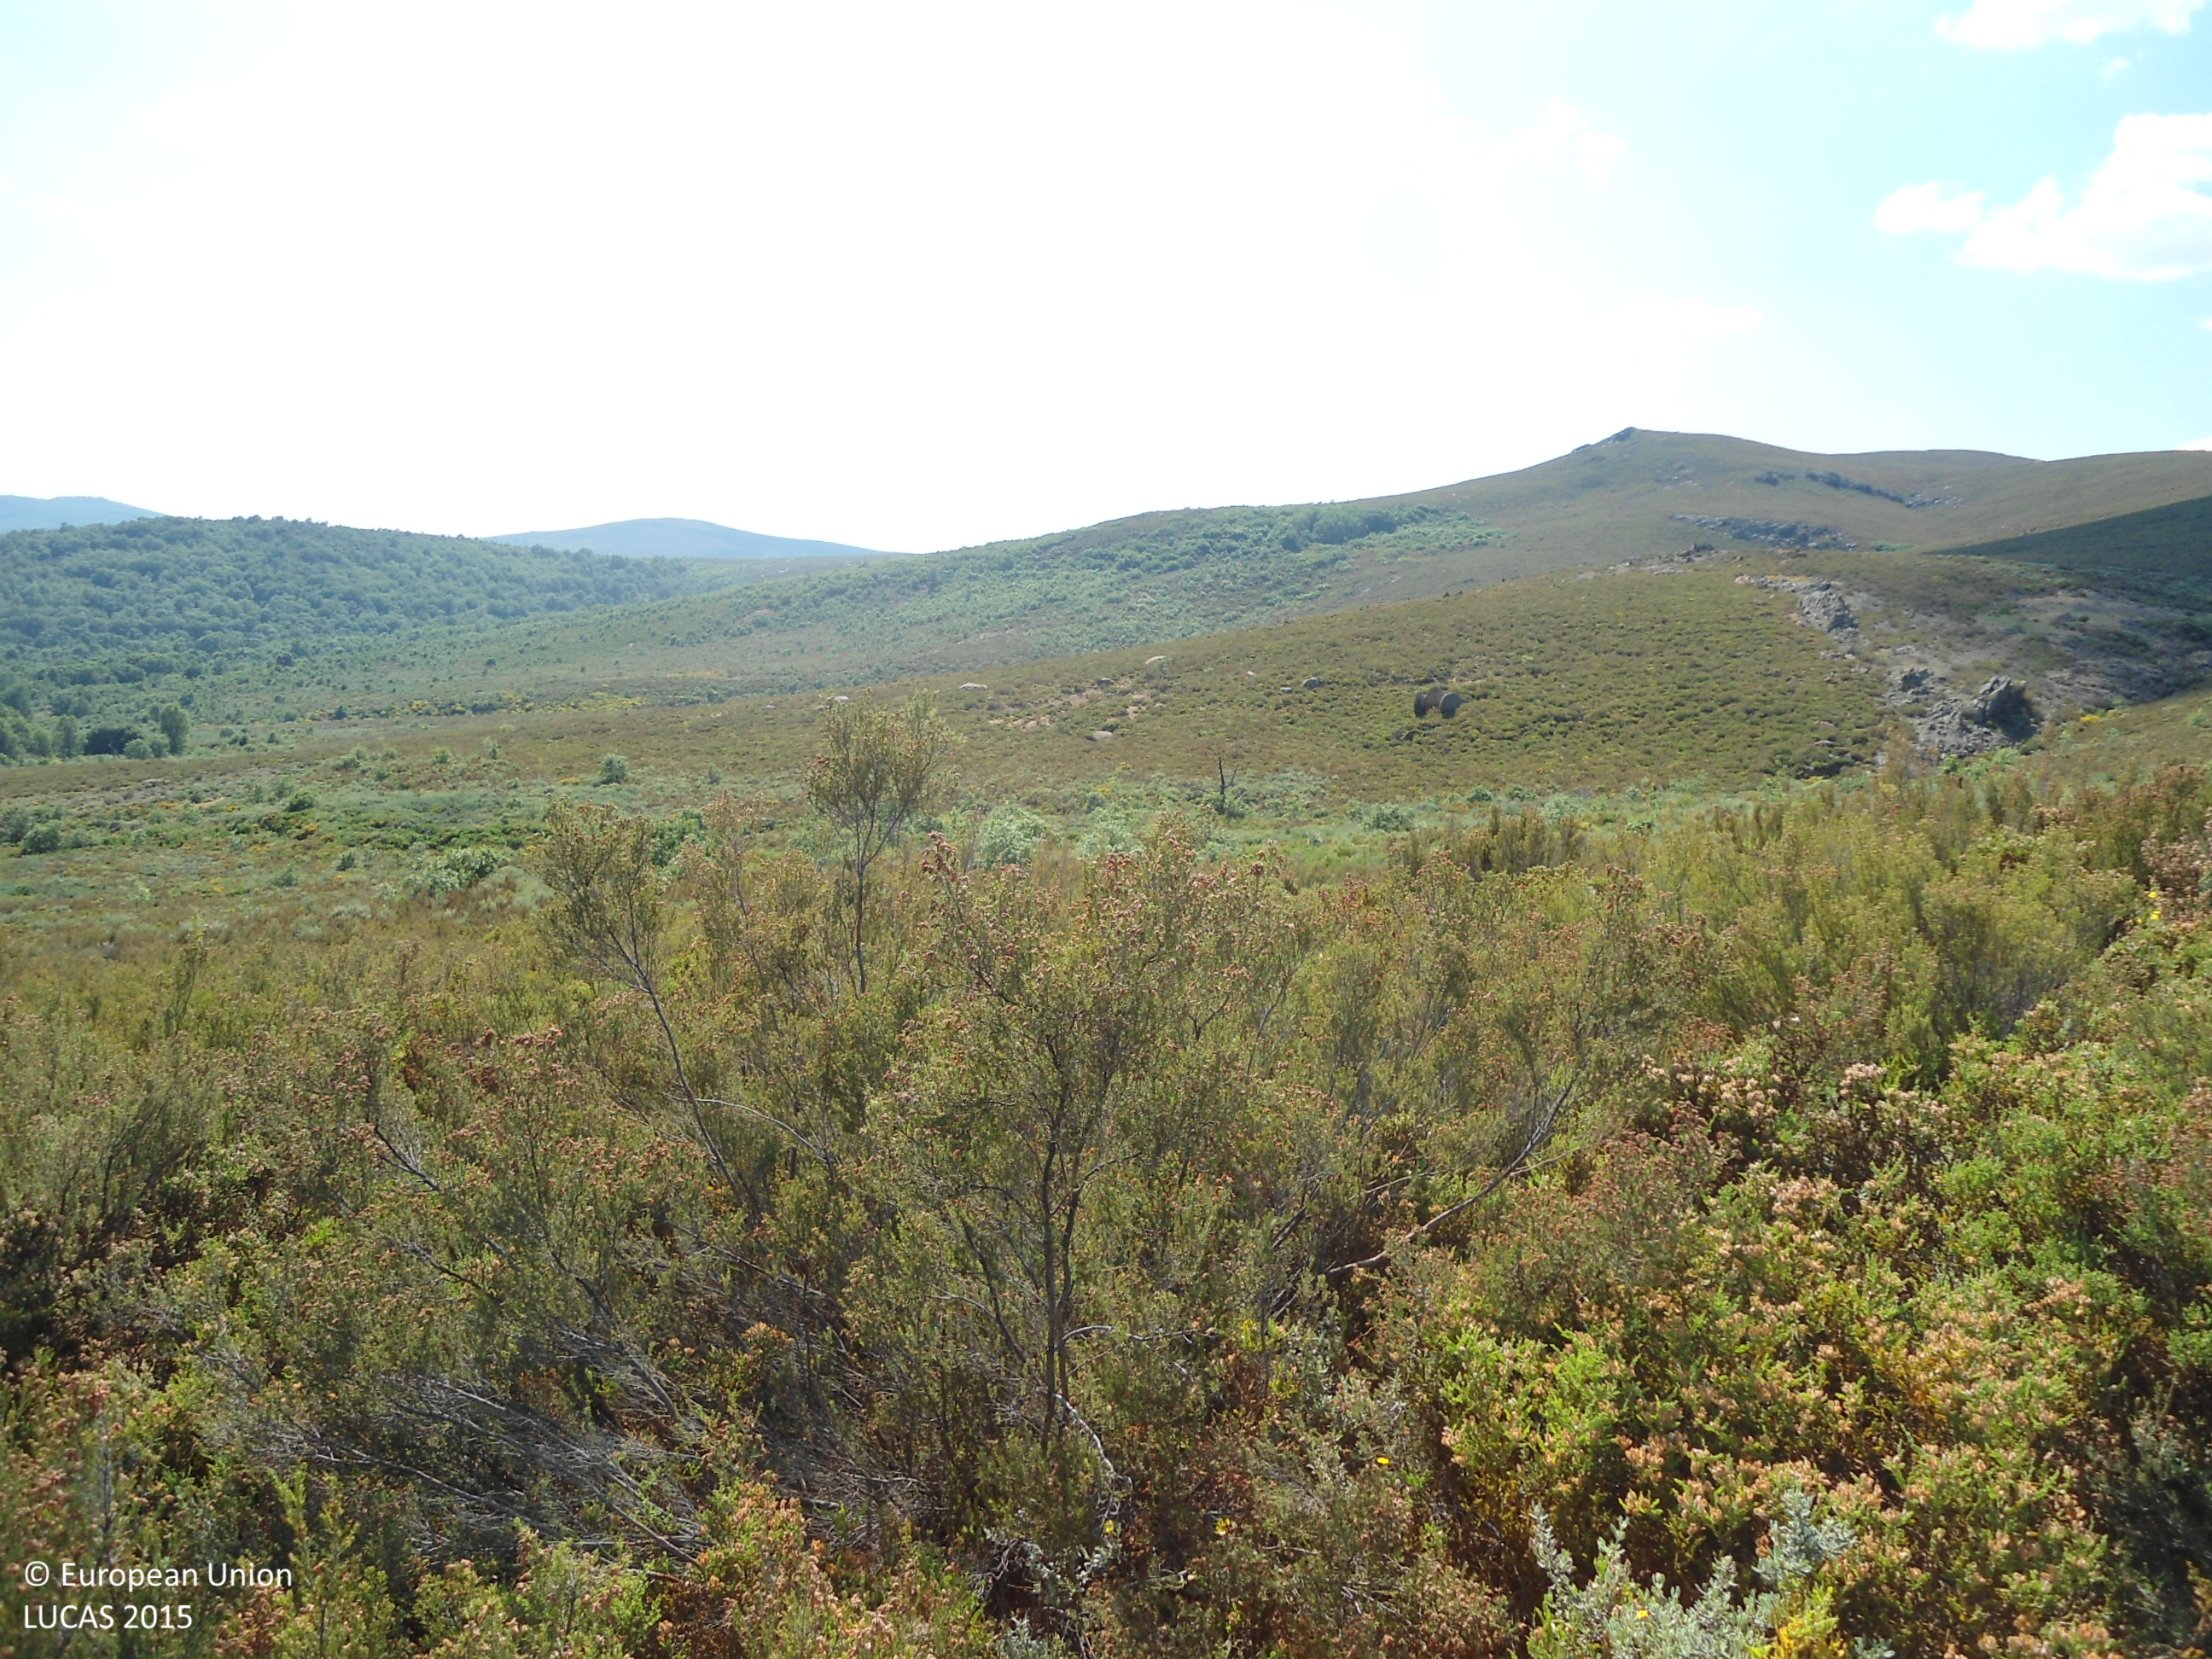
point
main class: Shrubland
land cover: Shrubland without tree cover
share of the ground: > 75 %
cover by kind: shrubs 100 %
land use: Semi-natural and natural areas not in use
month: June
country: ES
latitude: 42.1410
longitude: -6.3582
